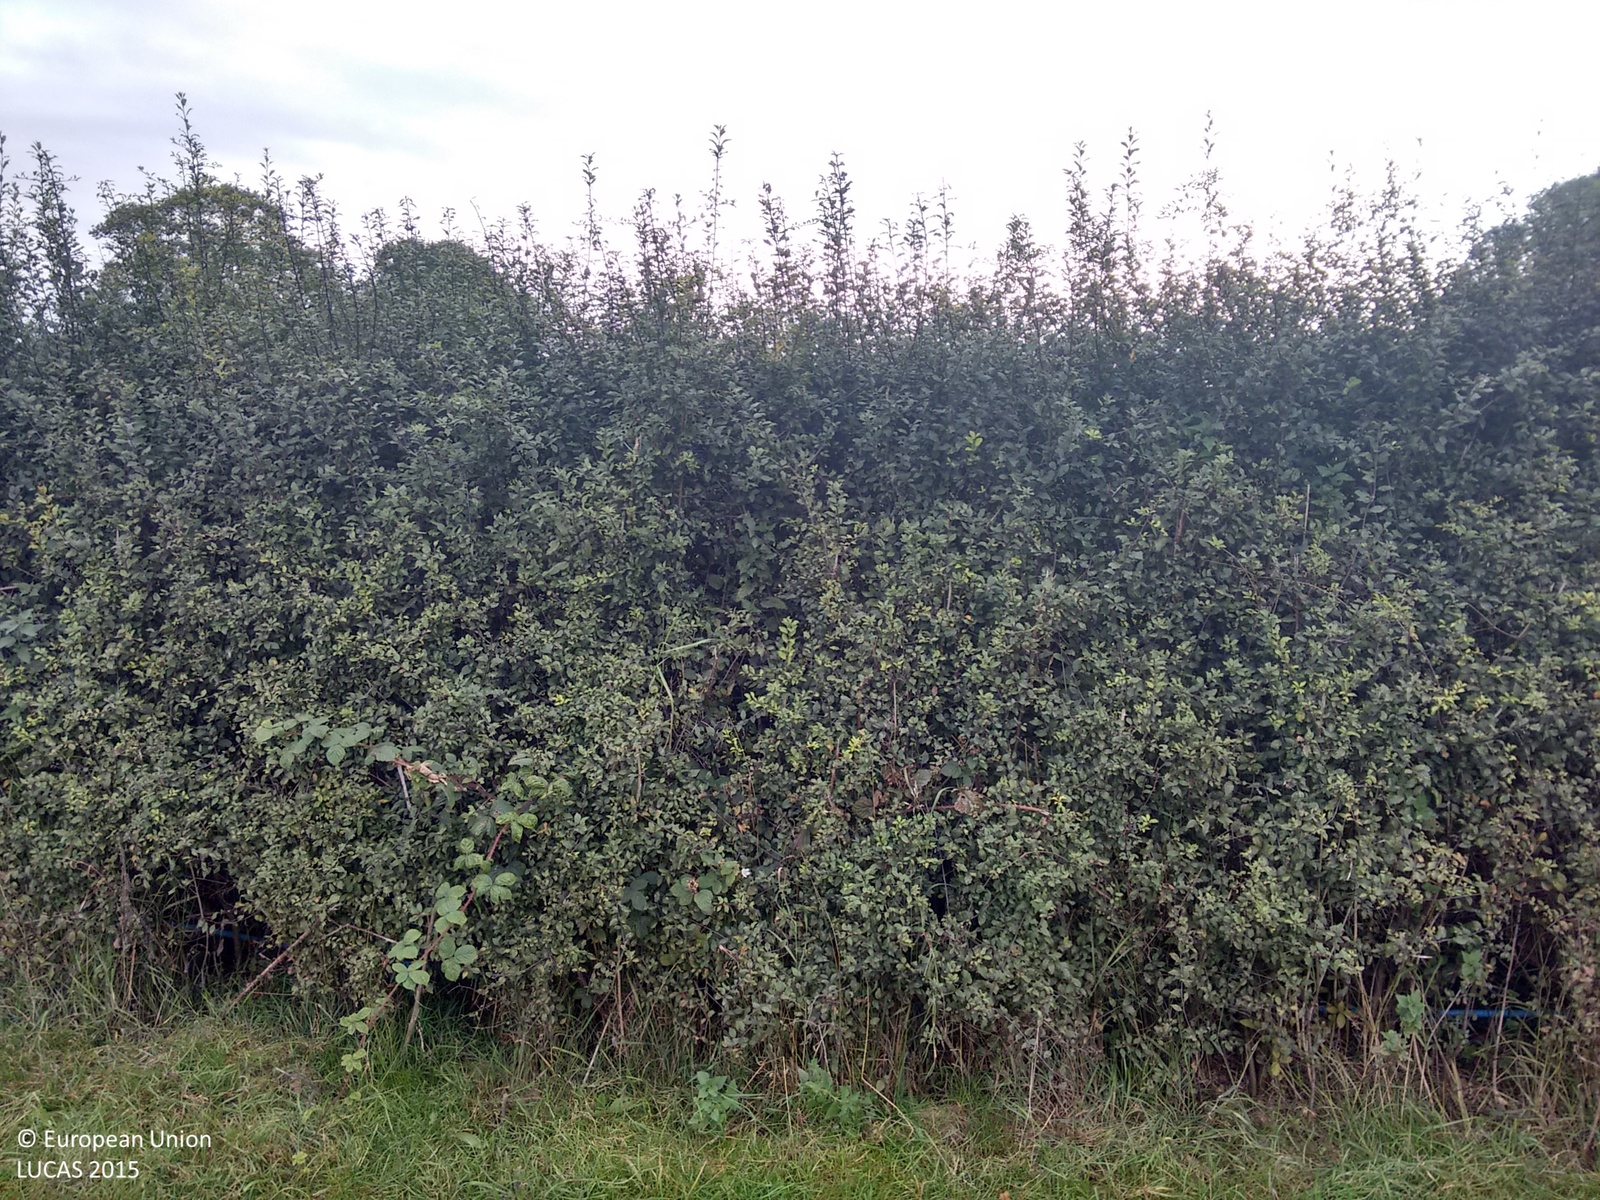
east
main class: Grassland
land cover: Grassland without tree/shrub cover
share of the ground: > 75 %
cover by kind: herbaceous plants 100 %
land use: Agriculture (excluding fallow land and kitchen gardens)
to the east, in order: Grassland without tree/shrub cover; Fences; Grass margins; Tracks; Abandoned hedges; Grassland without tree/shrub cover; Fences; Tracks; Fences; Grassland without tree/shrub cover
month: September
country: GB
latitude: 52.9049
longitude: -2.9343
